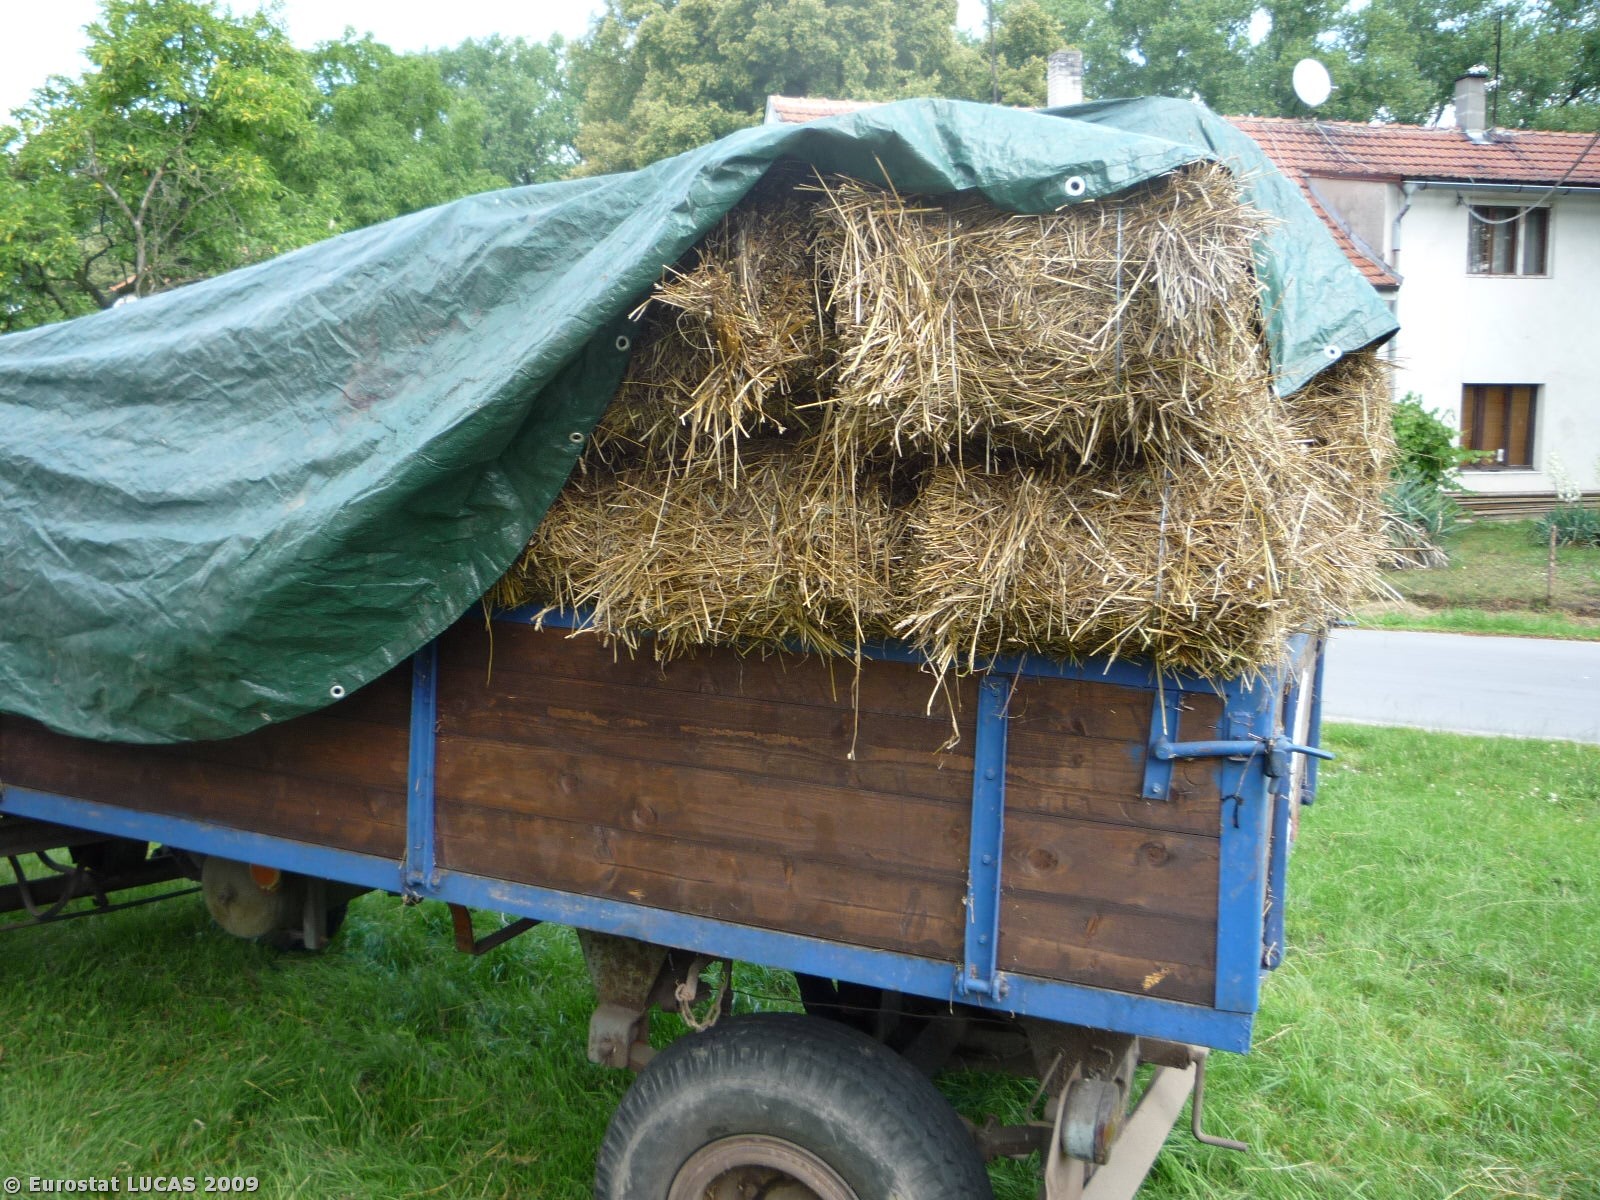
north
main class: Cropland
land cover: Pear fruit
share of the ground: 25 - 50 %
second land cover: Grassland with sparse tree/shrub cover
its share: > 75 %
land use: Kitchen garden
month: July
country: CZ
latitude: 50.1647
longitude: 15.0005
